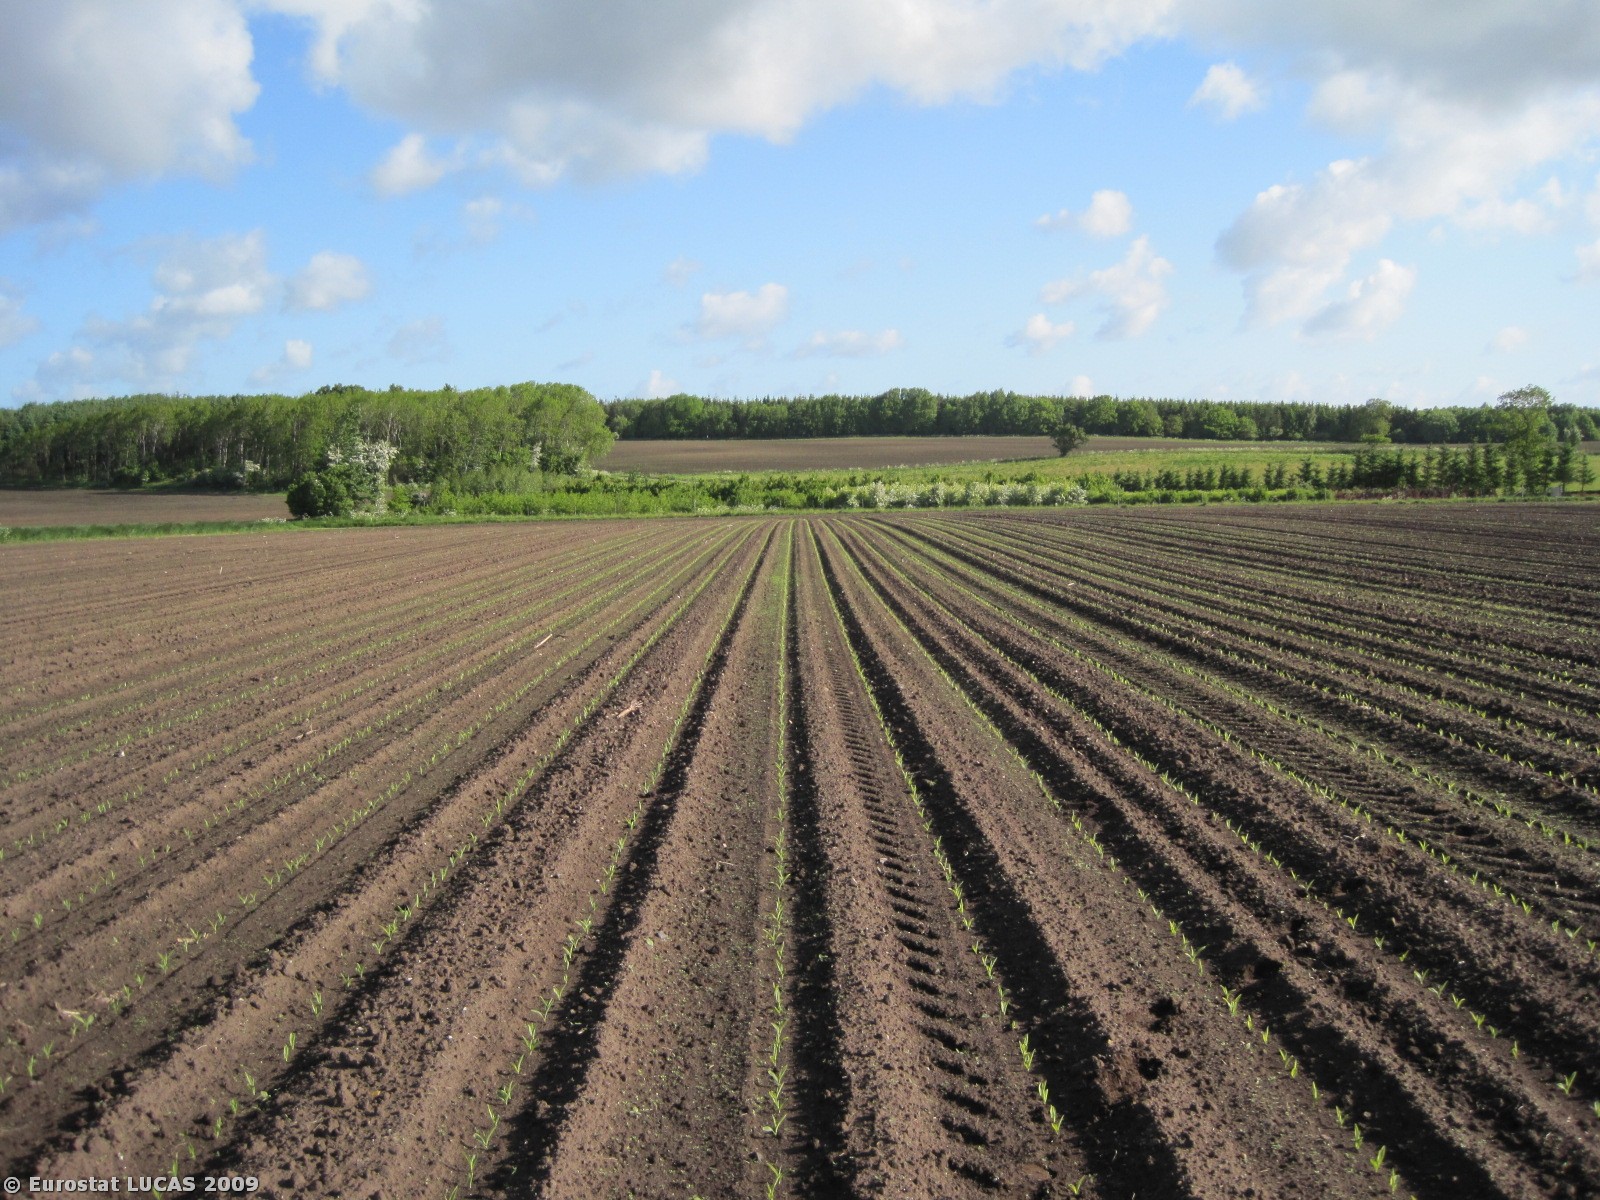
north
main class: Cropland
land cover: Maize
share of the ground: < 10 %
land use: Agriculture (excluding fallow land and kitchen gardens)
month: May
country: DK
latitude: 56.5109
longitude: 9.6917
